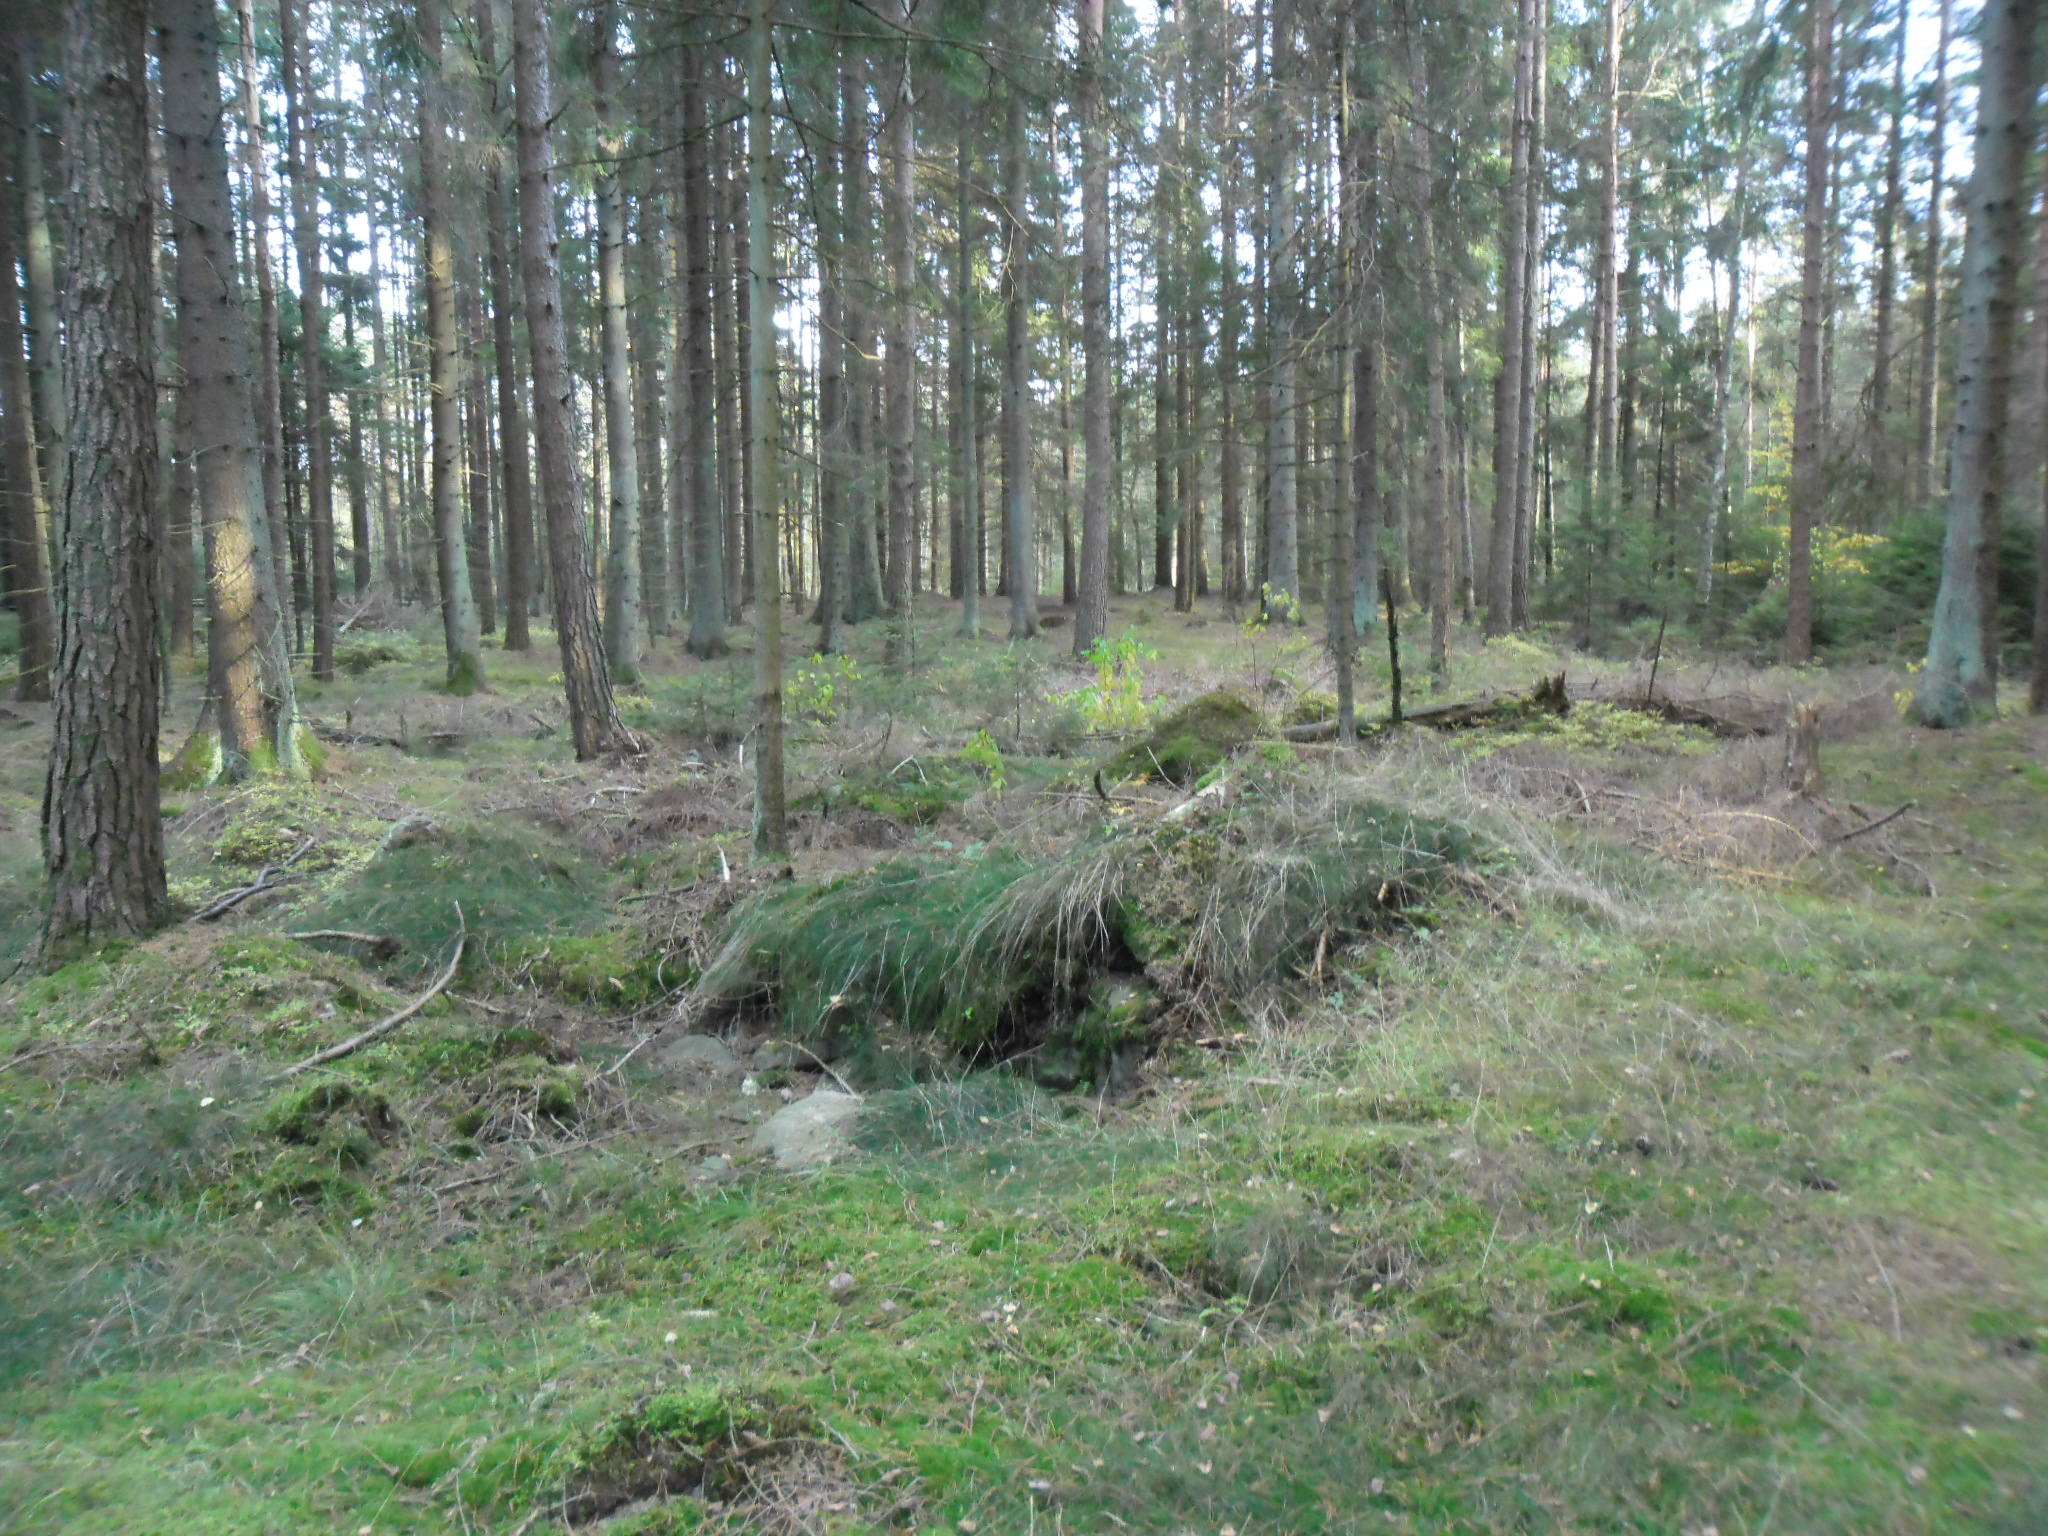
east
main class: Woodland
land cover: Spruce dominated coniferous woodland
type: boreal forest
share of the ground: > 75 %
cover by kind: coniferous forest trees 80 %, lichens and mosses 20 %
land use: Forestry
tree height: > 5 m
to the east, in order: Spruce dominated coniferous woodland; Pine dominated coniferous woodland; Grassland with sparse tree/shrub cover; Spruce dominated mixed woodland; Tracks; Other mixed woodland
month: October
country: SE
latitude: 56.4001
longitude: 13.1891
